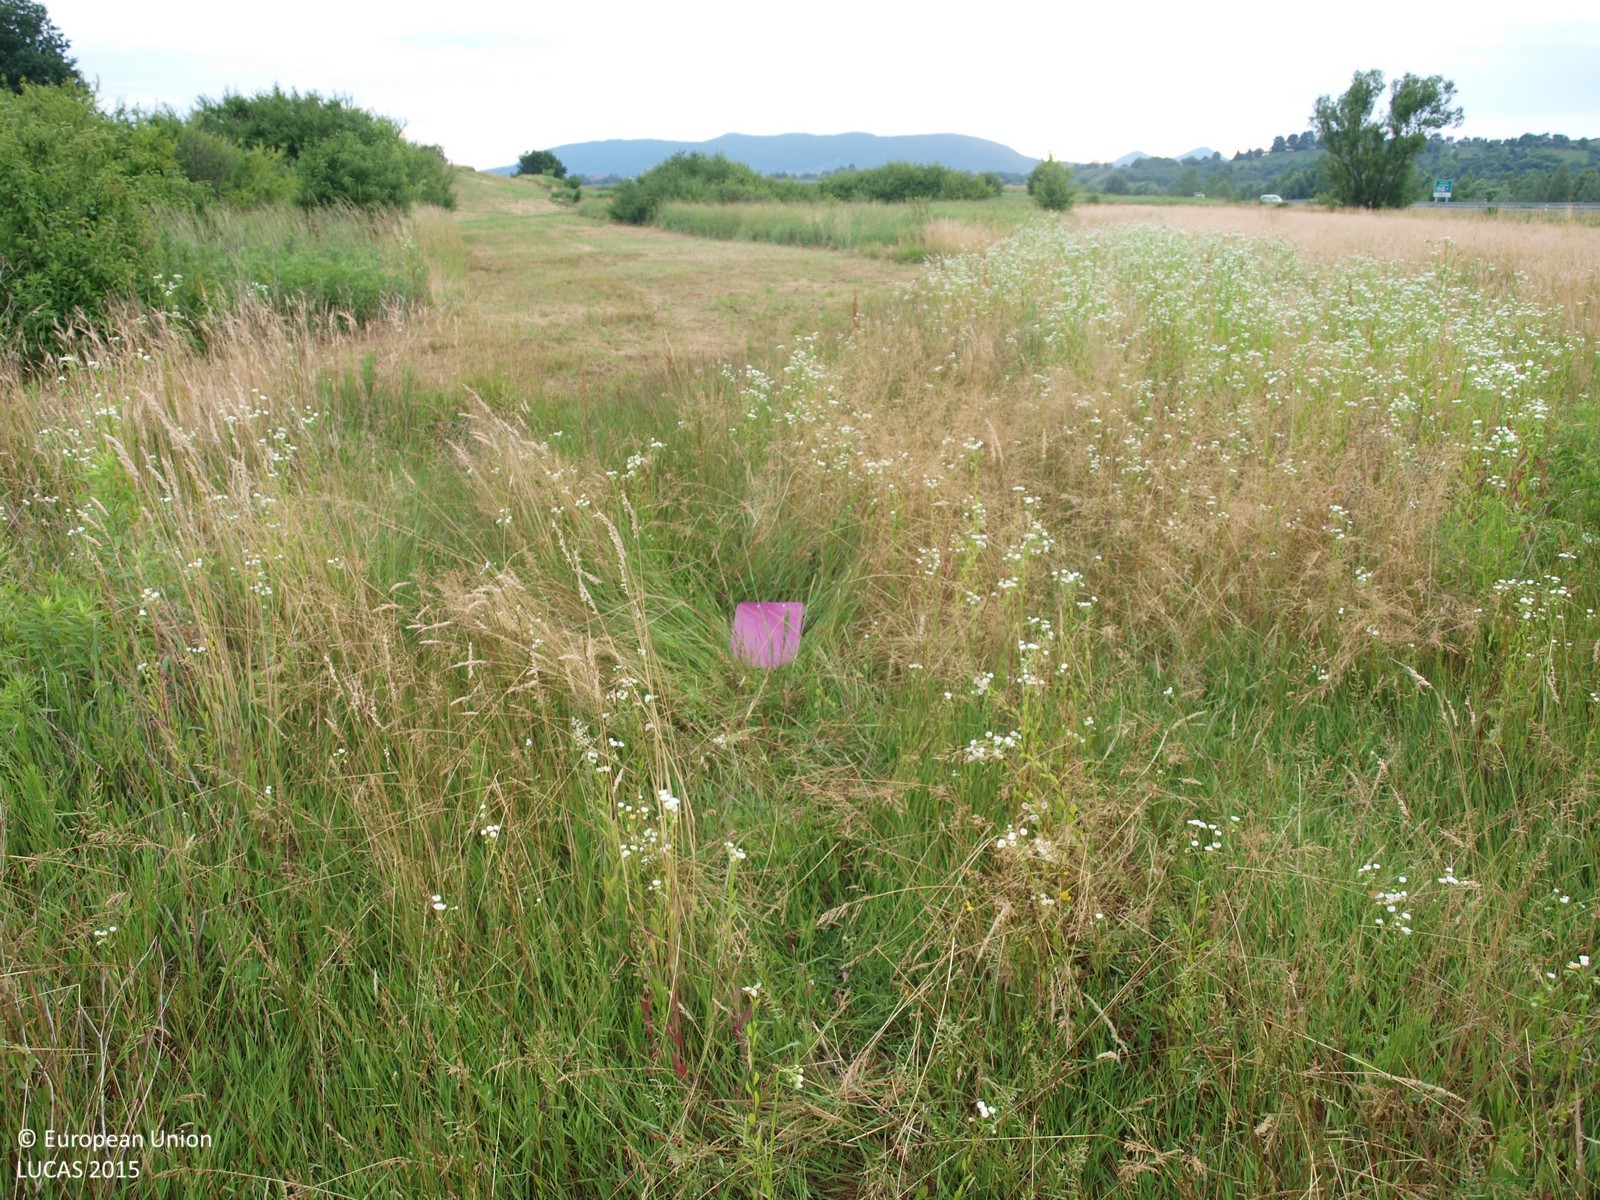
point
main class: Grassland
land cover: Grassland without tree/shrub cover
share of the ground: > 75 %
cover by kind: herbaceous plants 100 %
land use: Agriculture (excluding fallow land and kitchen gardens)
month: June
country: HR
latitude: 46.1784
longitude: 16.3863
